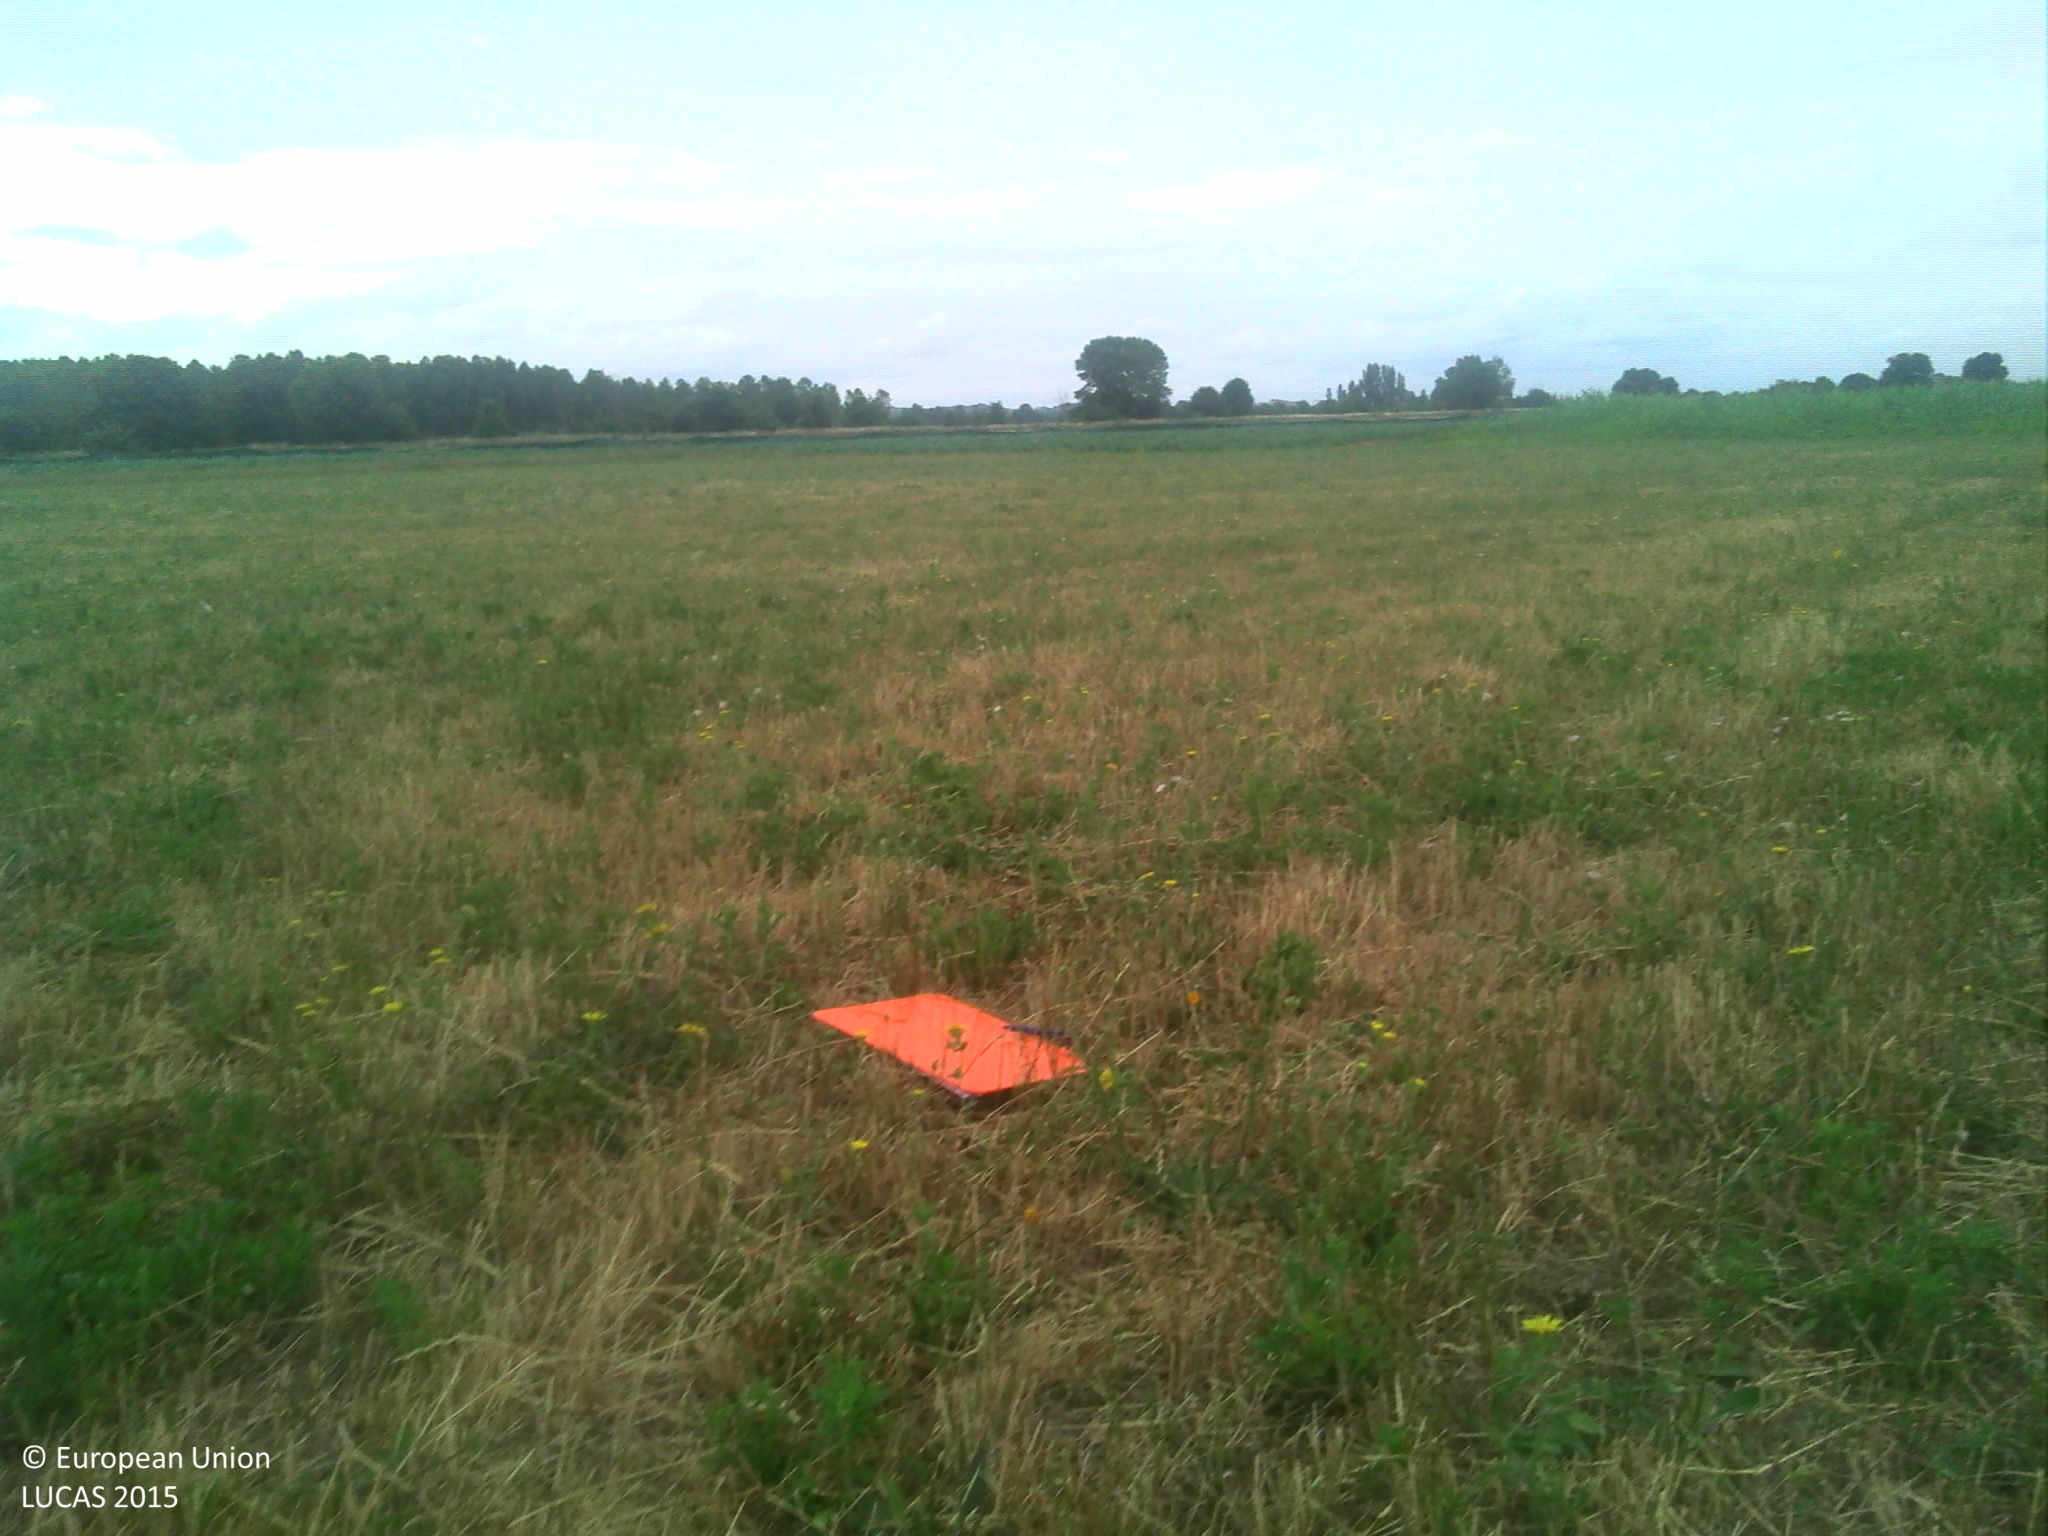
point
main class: Grassland
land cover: Grassland without tree/shrub cover
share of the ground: > 75 %
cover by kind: herbaceous plants 100 %
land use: Agriculture (excluding fallow land and kitchen gardens)
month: July
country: FR
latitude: 43.3607
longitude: 1.4282
